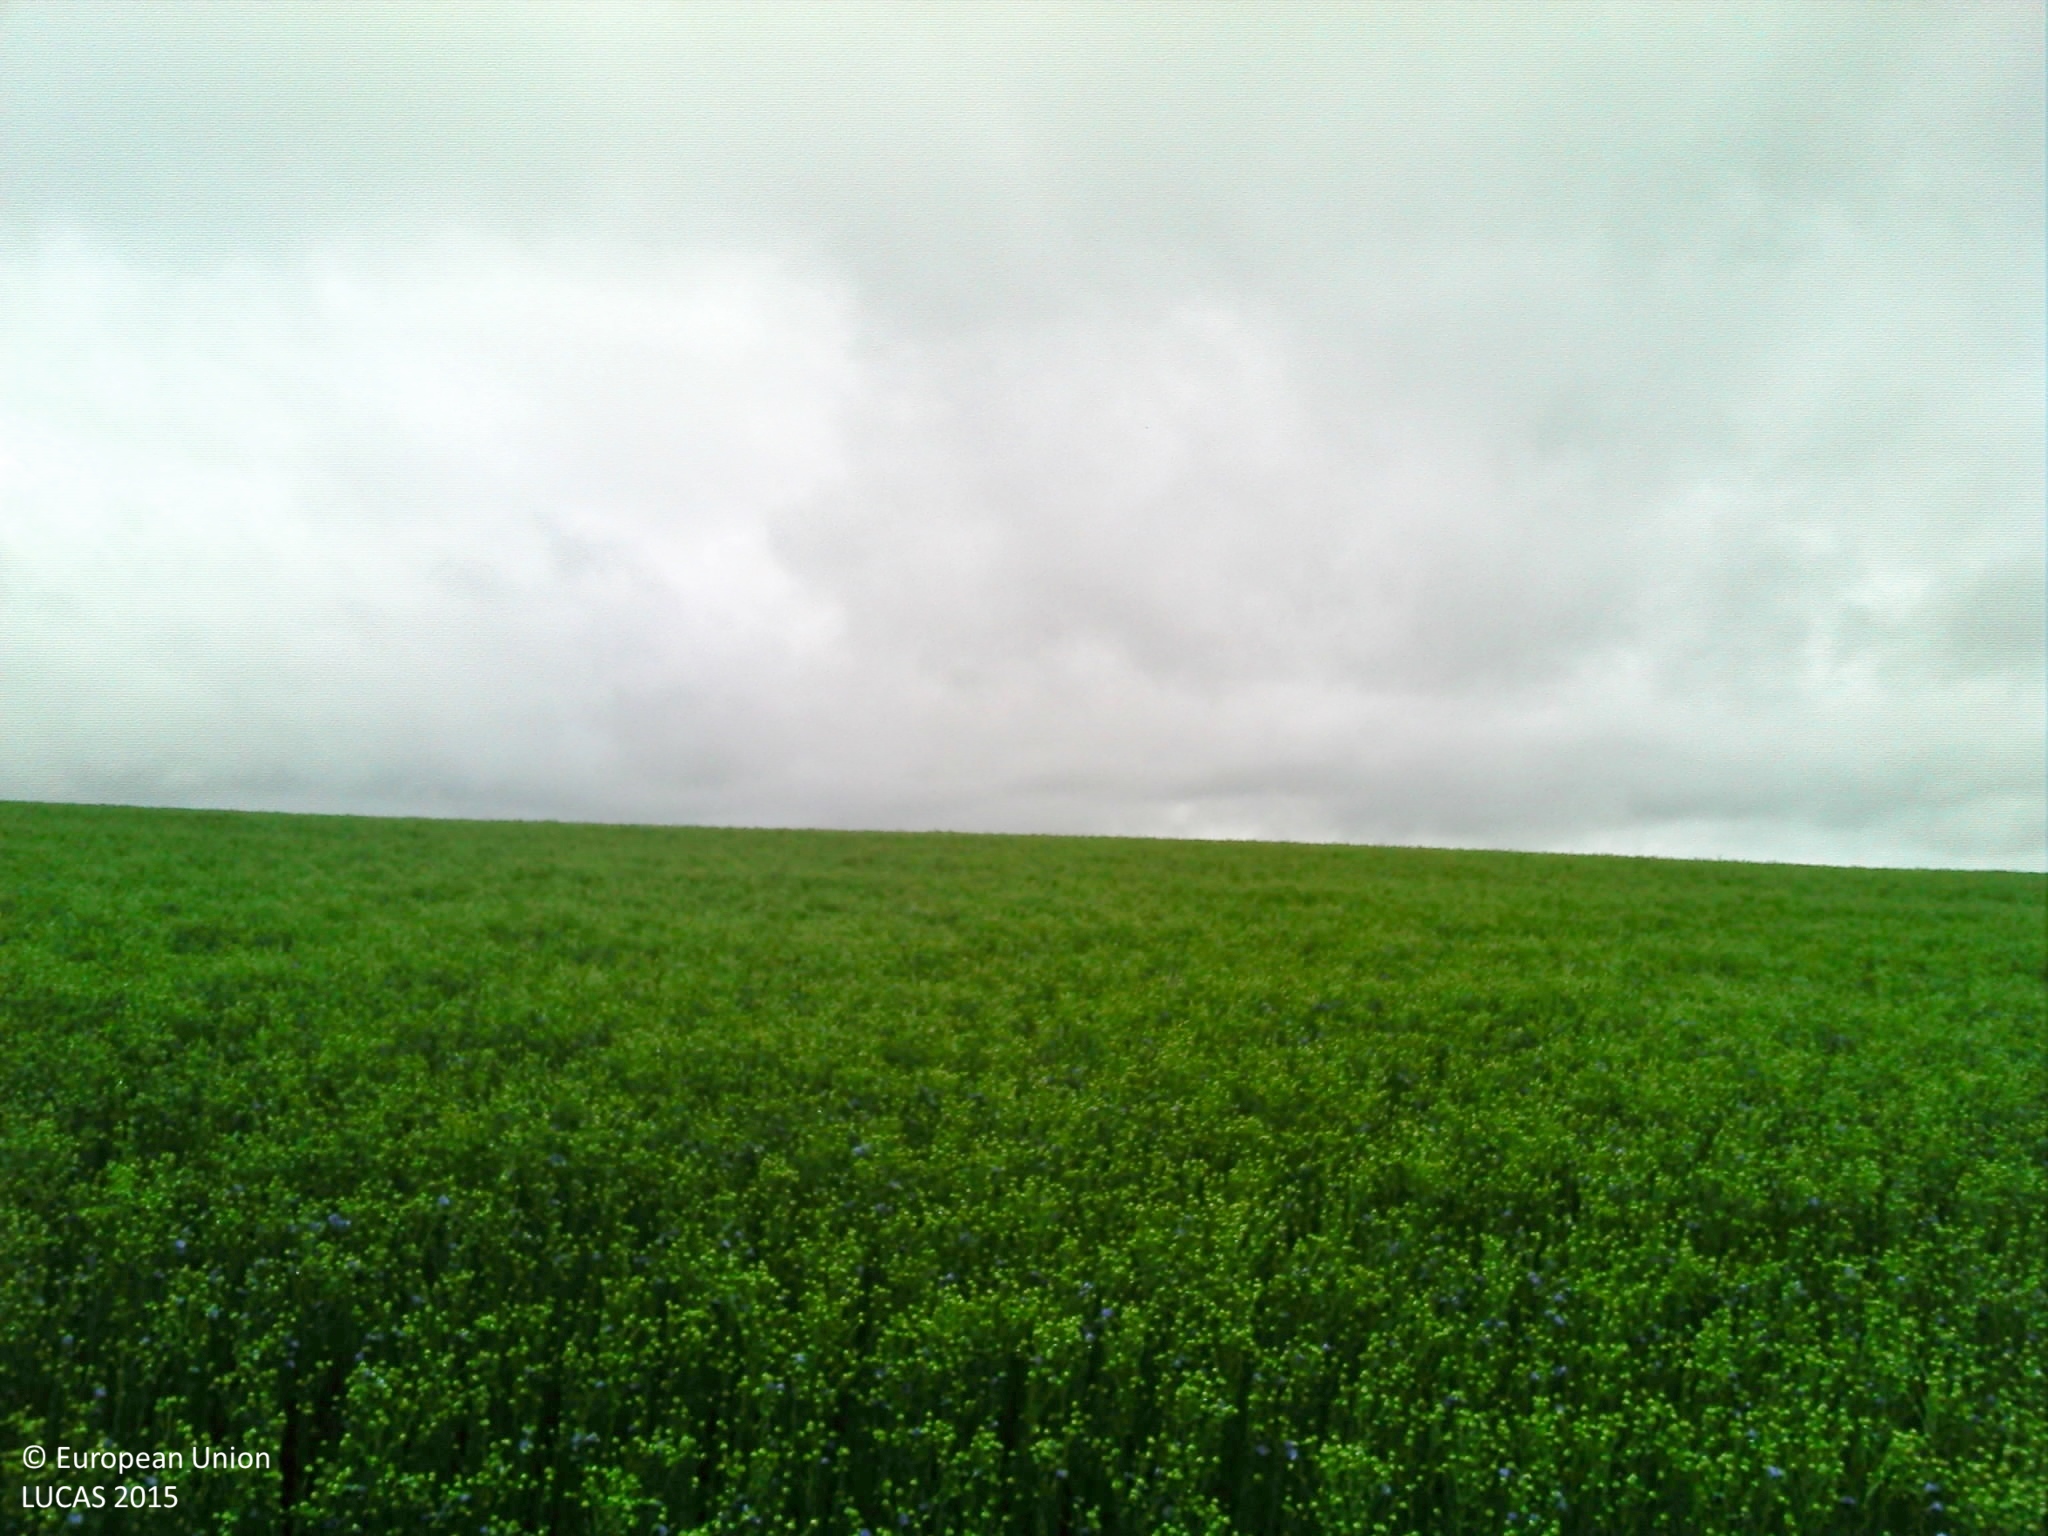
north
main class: Cropland
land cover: Other fibre and oleaginous crops
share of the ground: > 75 %
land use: Agriculture (excluding fallow land and kitchen gardens)
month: June
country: FR
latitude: 49.5171
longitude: 2.4320
